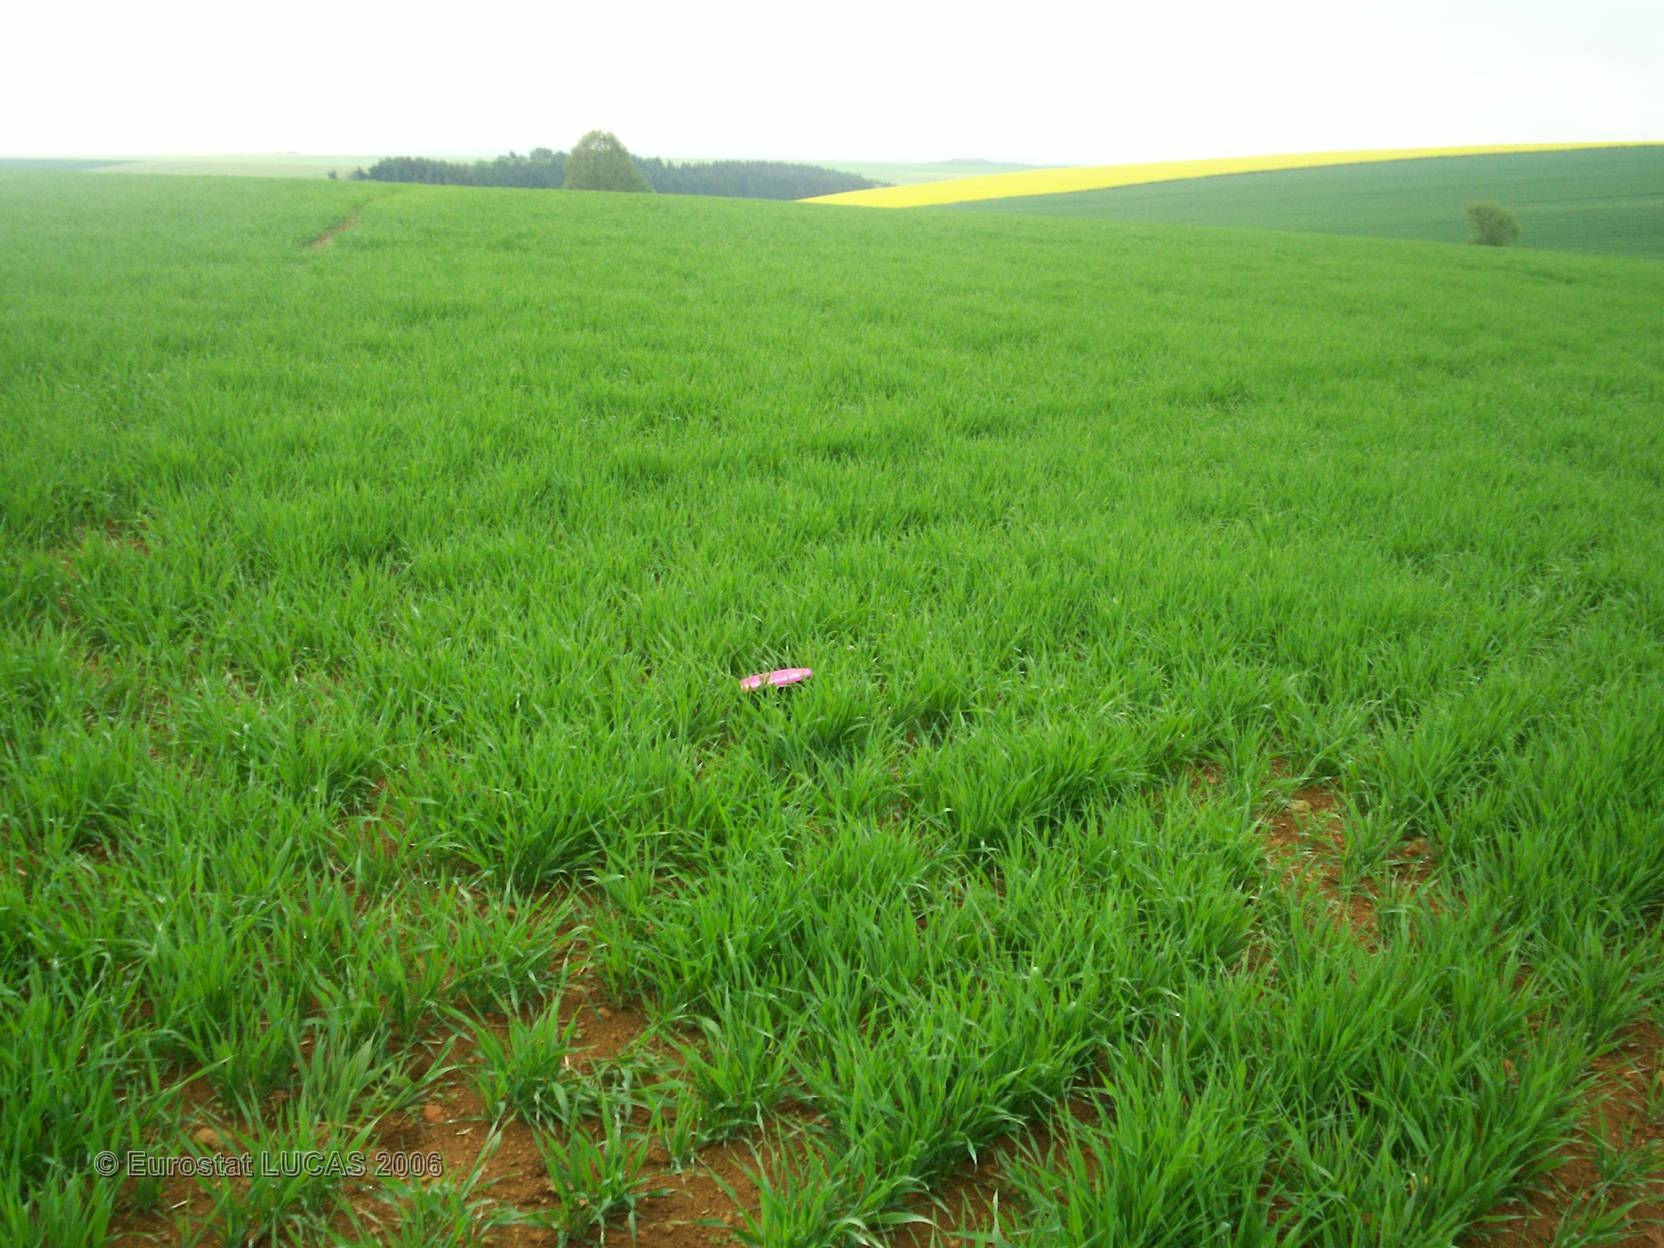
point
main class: Cropland
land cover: Barley
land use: Agriculture (excluding fallow land and kitchen gardens)
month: May
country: FR
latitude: 49.0853
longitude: 5.9328
